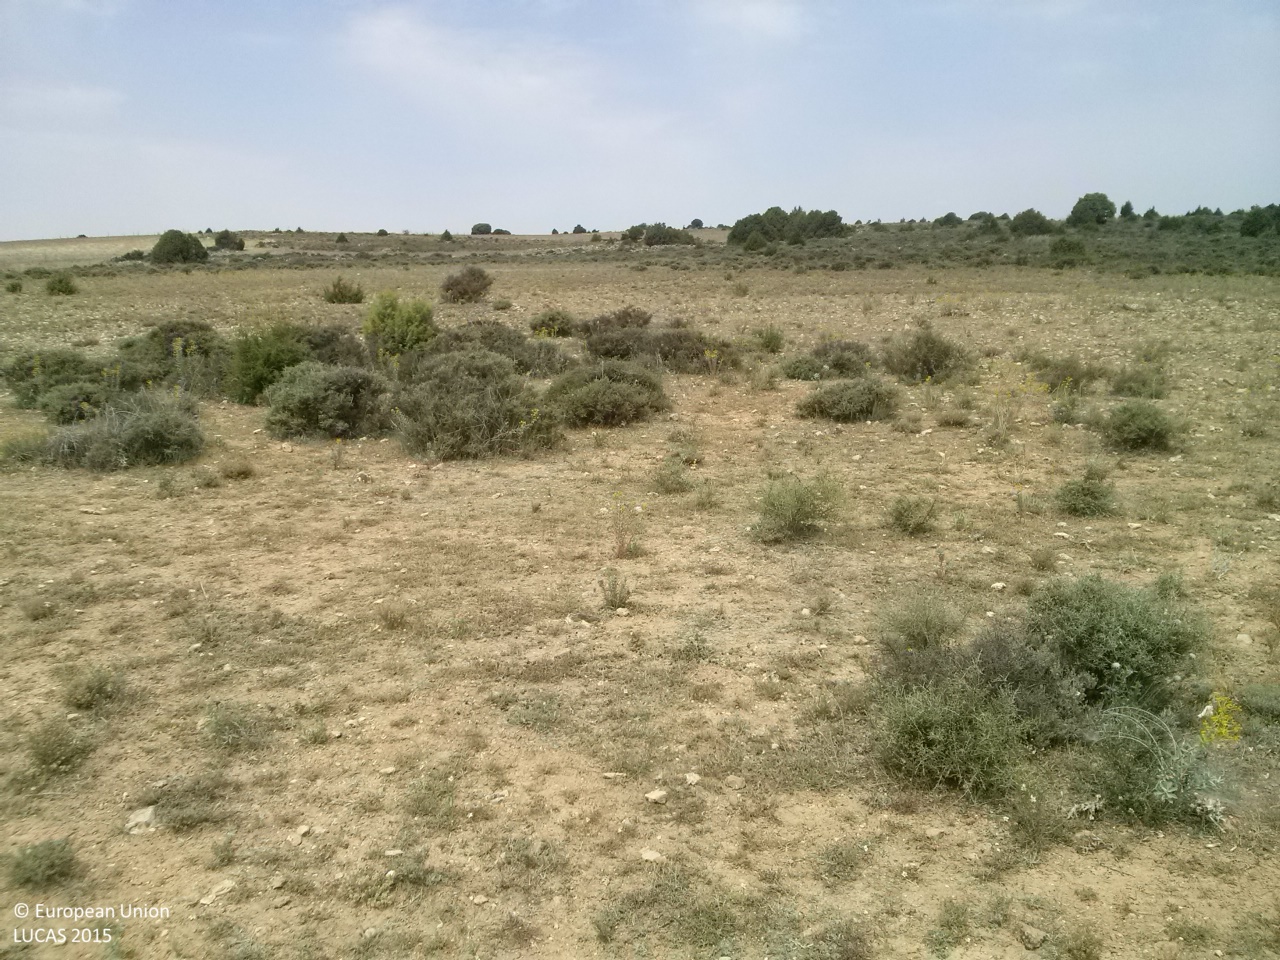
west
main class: Shrubland
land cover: Shrubland without tree cover
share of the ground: 25 - 50 %
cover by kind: shrubs 40 %, herbaceous plants 30 %, unconsolidated bare surface 30 %
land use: Agriculture (excluding fallow land and kitchen gardens)
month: June
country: ES
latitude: 39.9517
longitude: -1.8221
